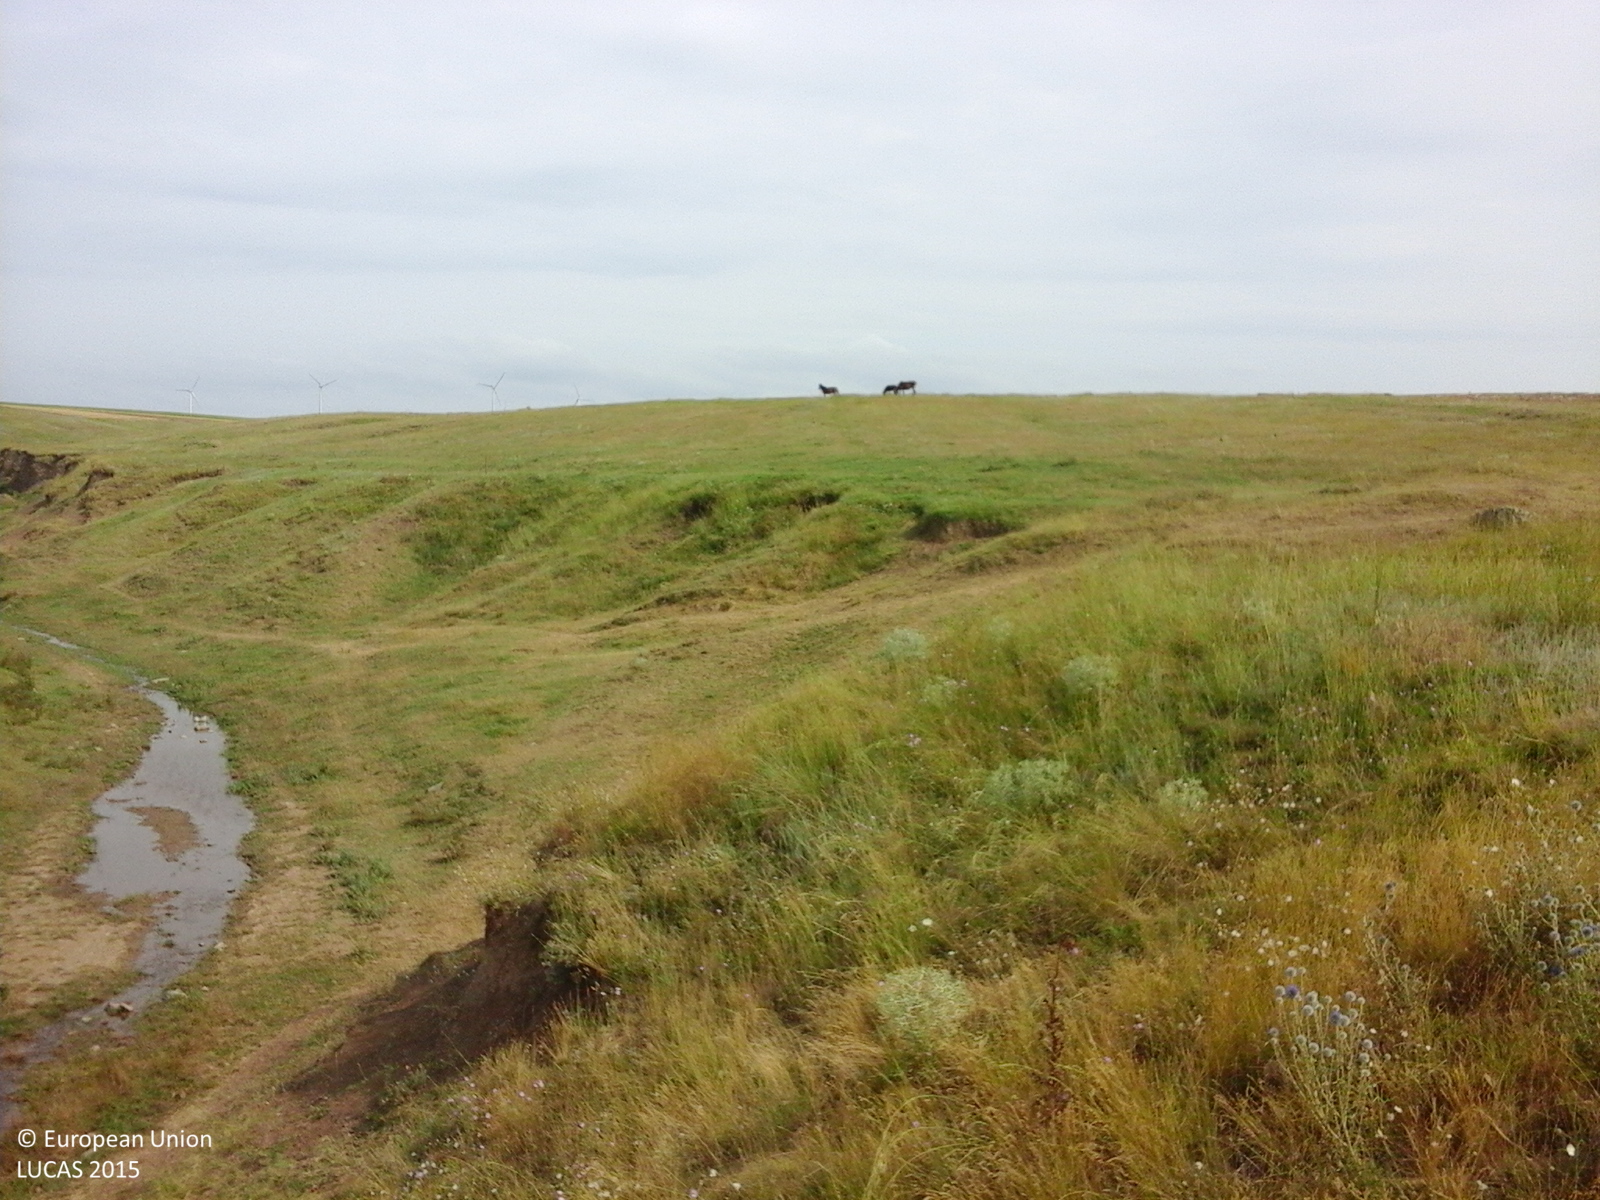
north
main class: Grassland
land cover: Grassland without tree/shrub cover
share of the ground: > 75 %
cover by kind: herbaceous plants 100 %
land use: Agriculture (excluding fallow land and kitchen gardens)
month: August
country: RO
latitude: 44.7240
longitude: 28.5741
